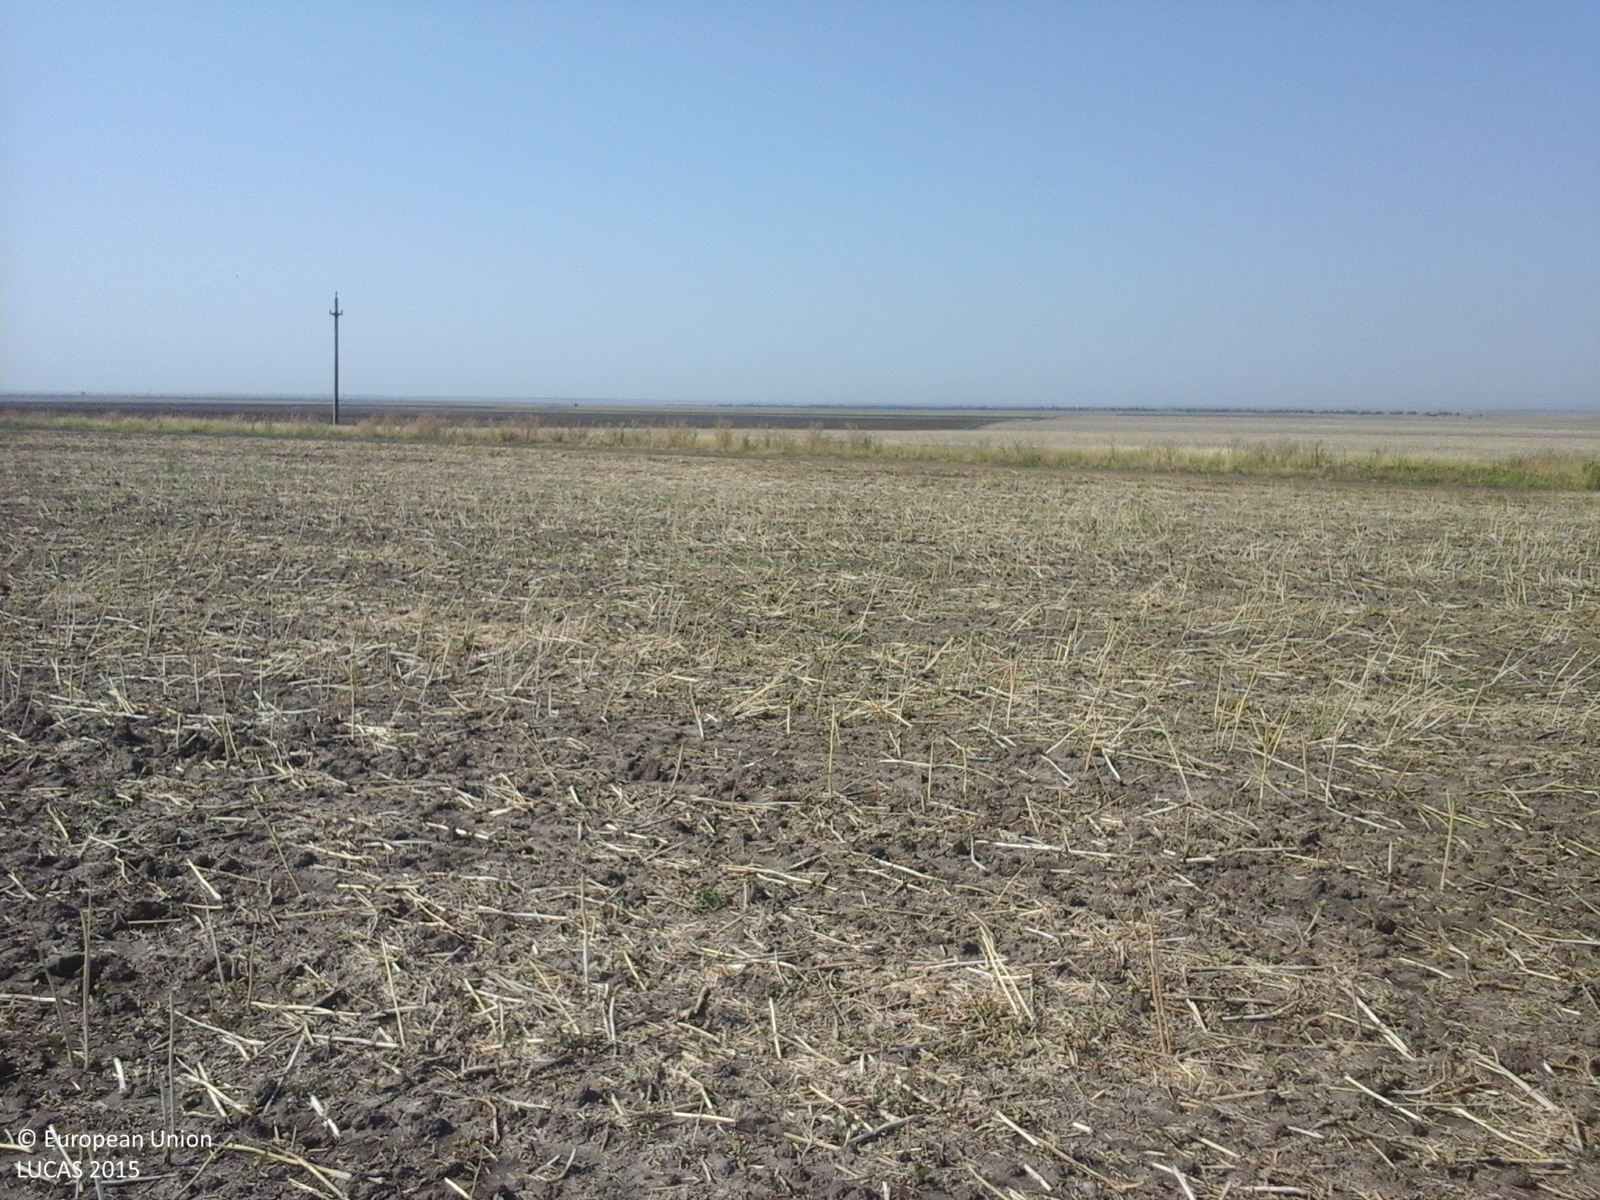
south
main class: Cropland
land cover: Rape and turnip rape
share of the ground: 10 - 25 %
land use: Agriculture (excluding fallow land and kitchen gardens)
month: August
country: RO
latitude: 44.2308
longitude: 23.0773
